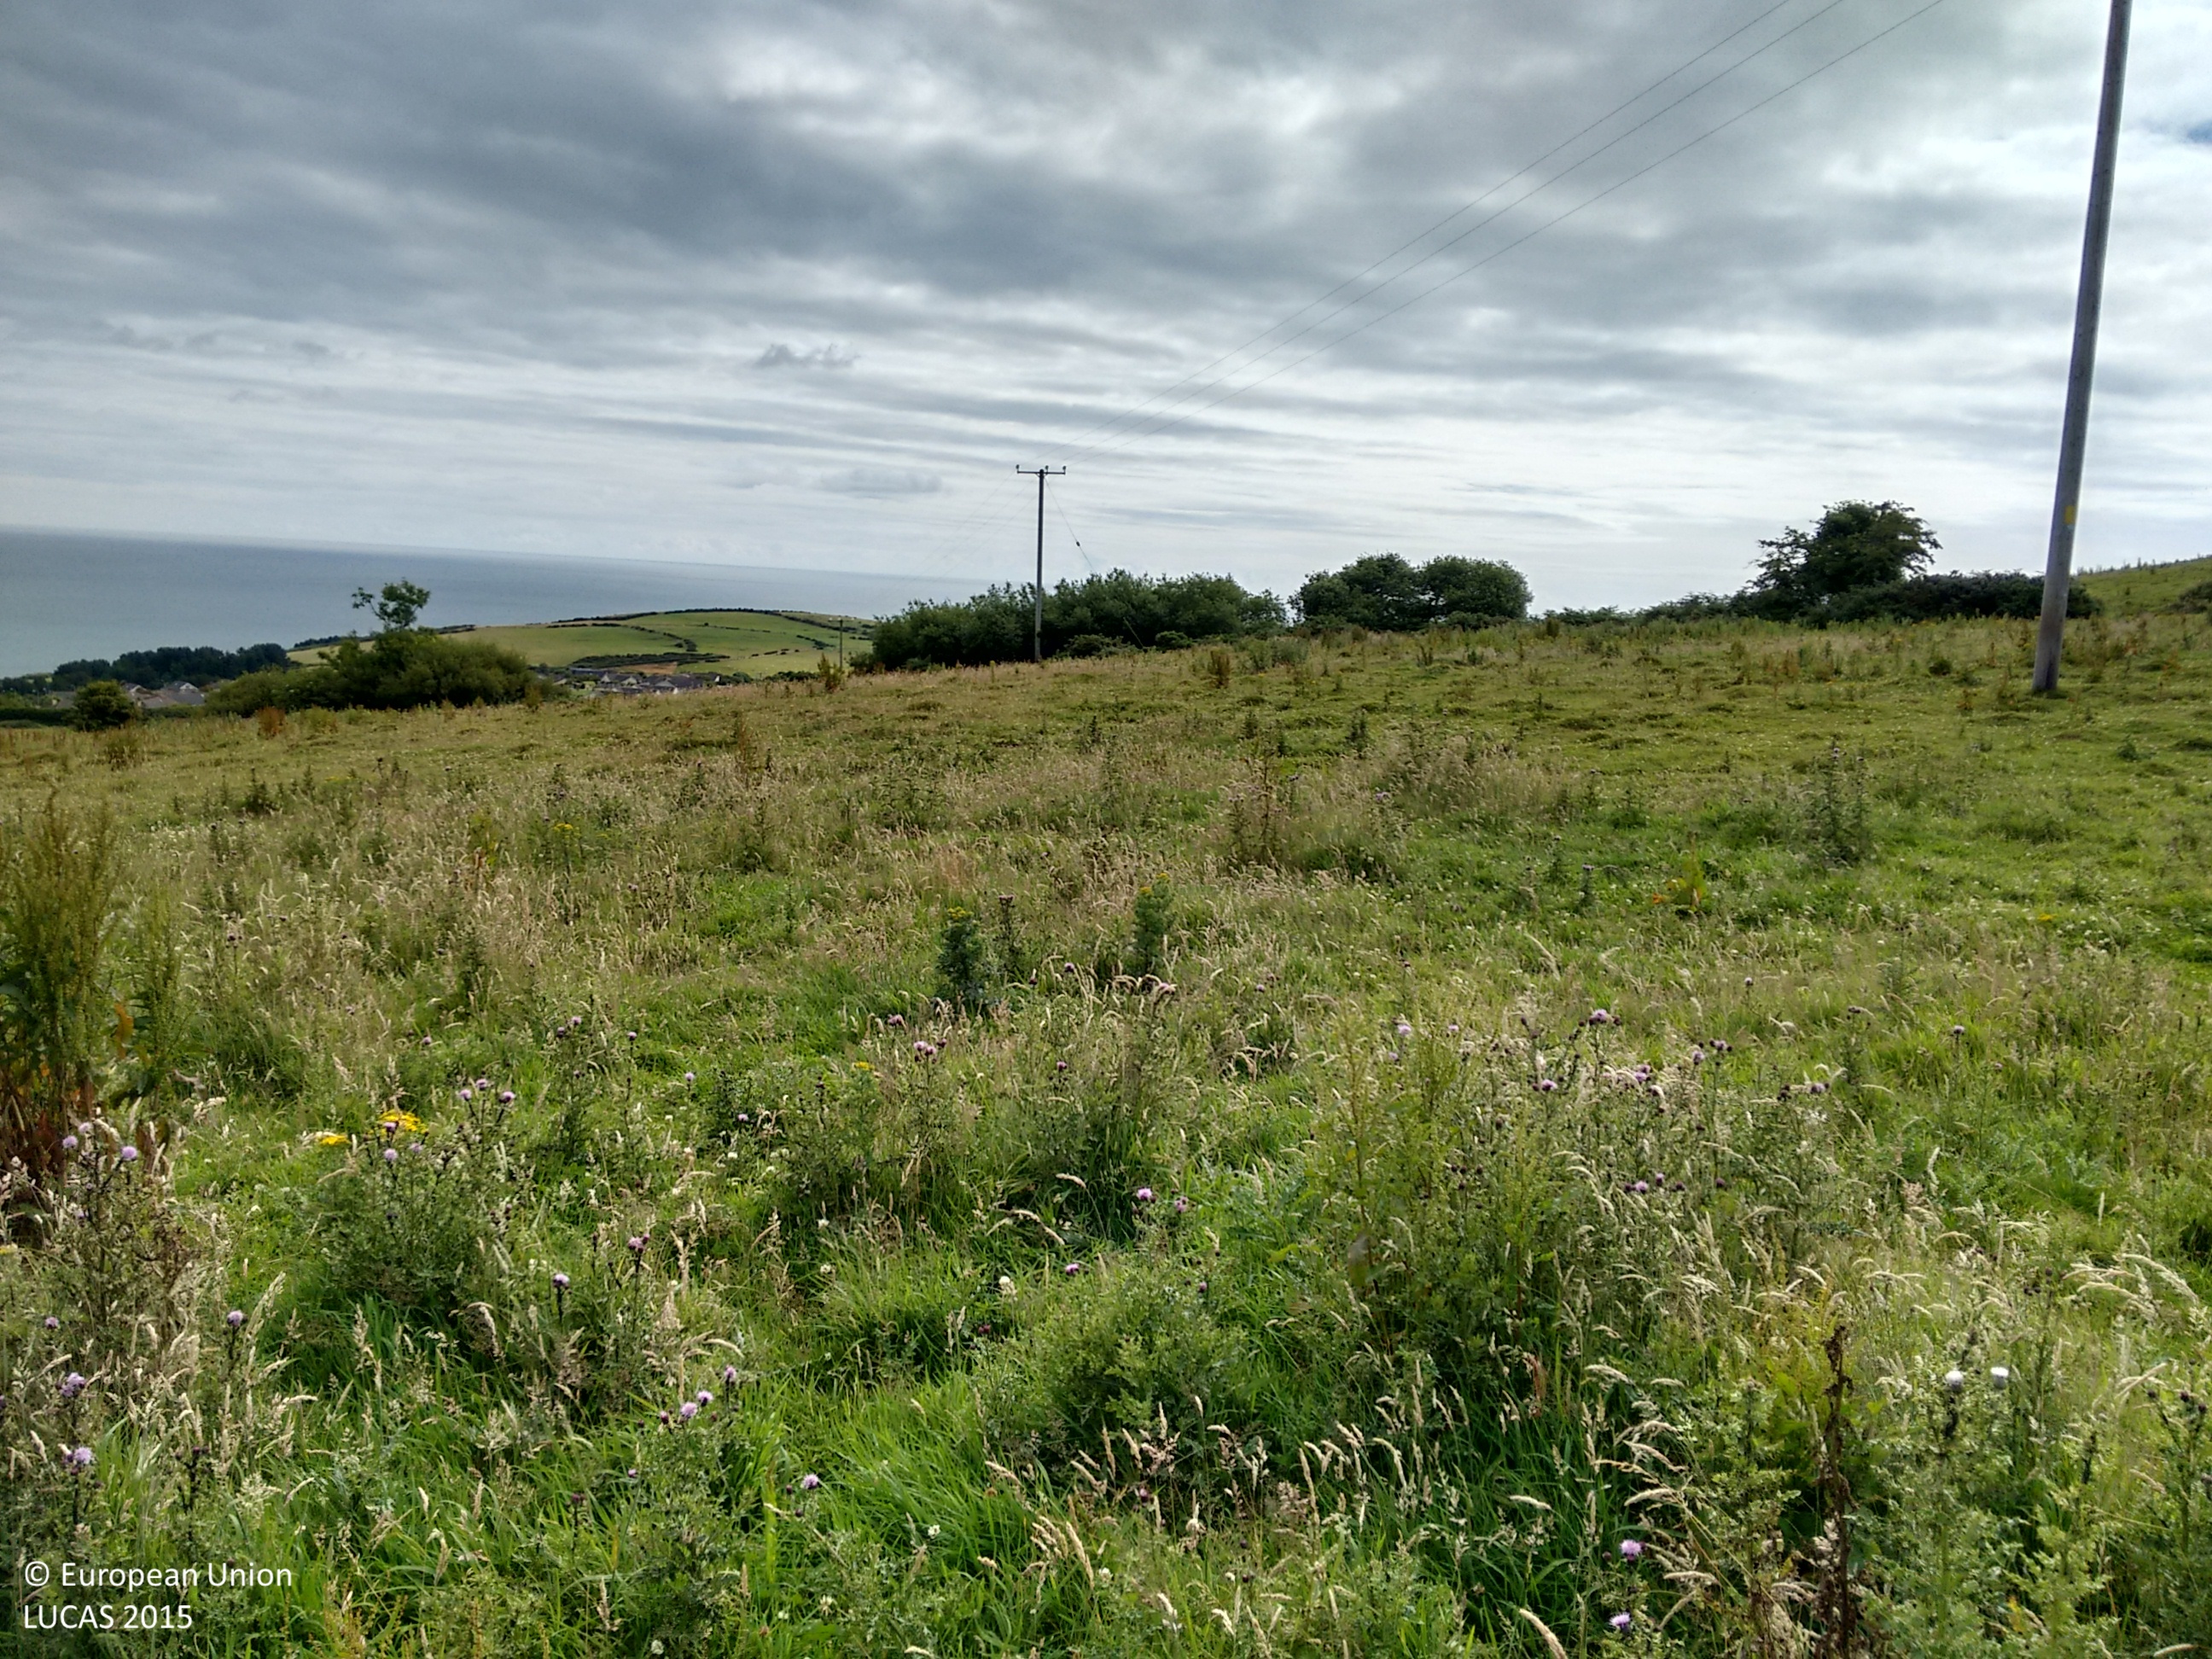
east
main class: Grassland
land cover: Grassland without tree/shrub cover
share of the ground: > 75 %
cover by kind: herbaceous plants 100 %
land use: Agriculture (excluding fallow land and kitchen gardens)
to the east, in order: Grassland without tree/shrub cover; Managed hedges; Grassland without tree/shrub cover
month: July
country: IE
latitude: 52.9662
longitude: -6.0302
